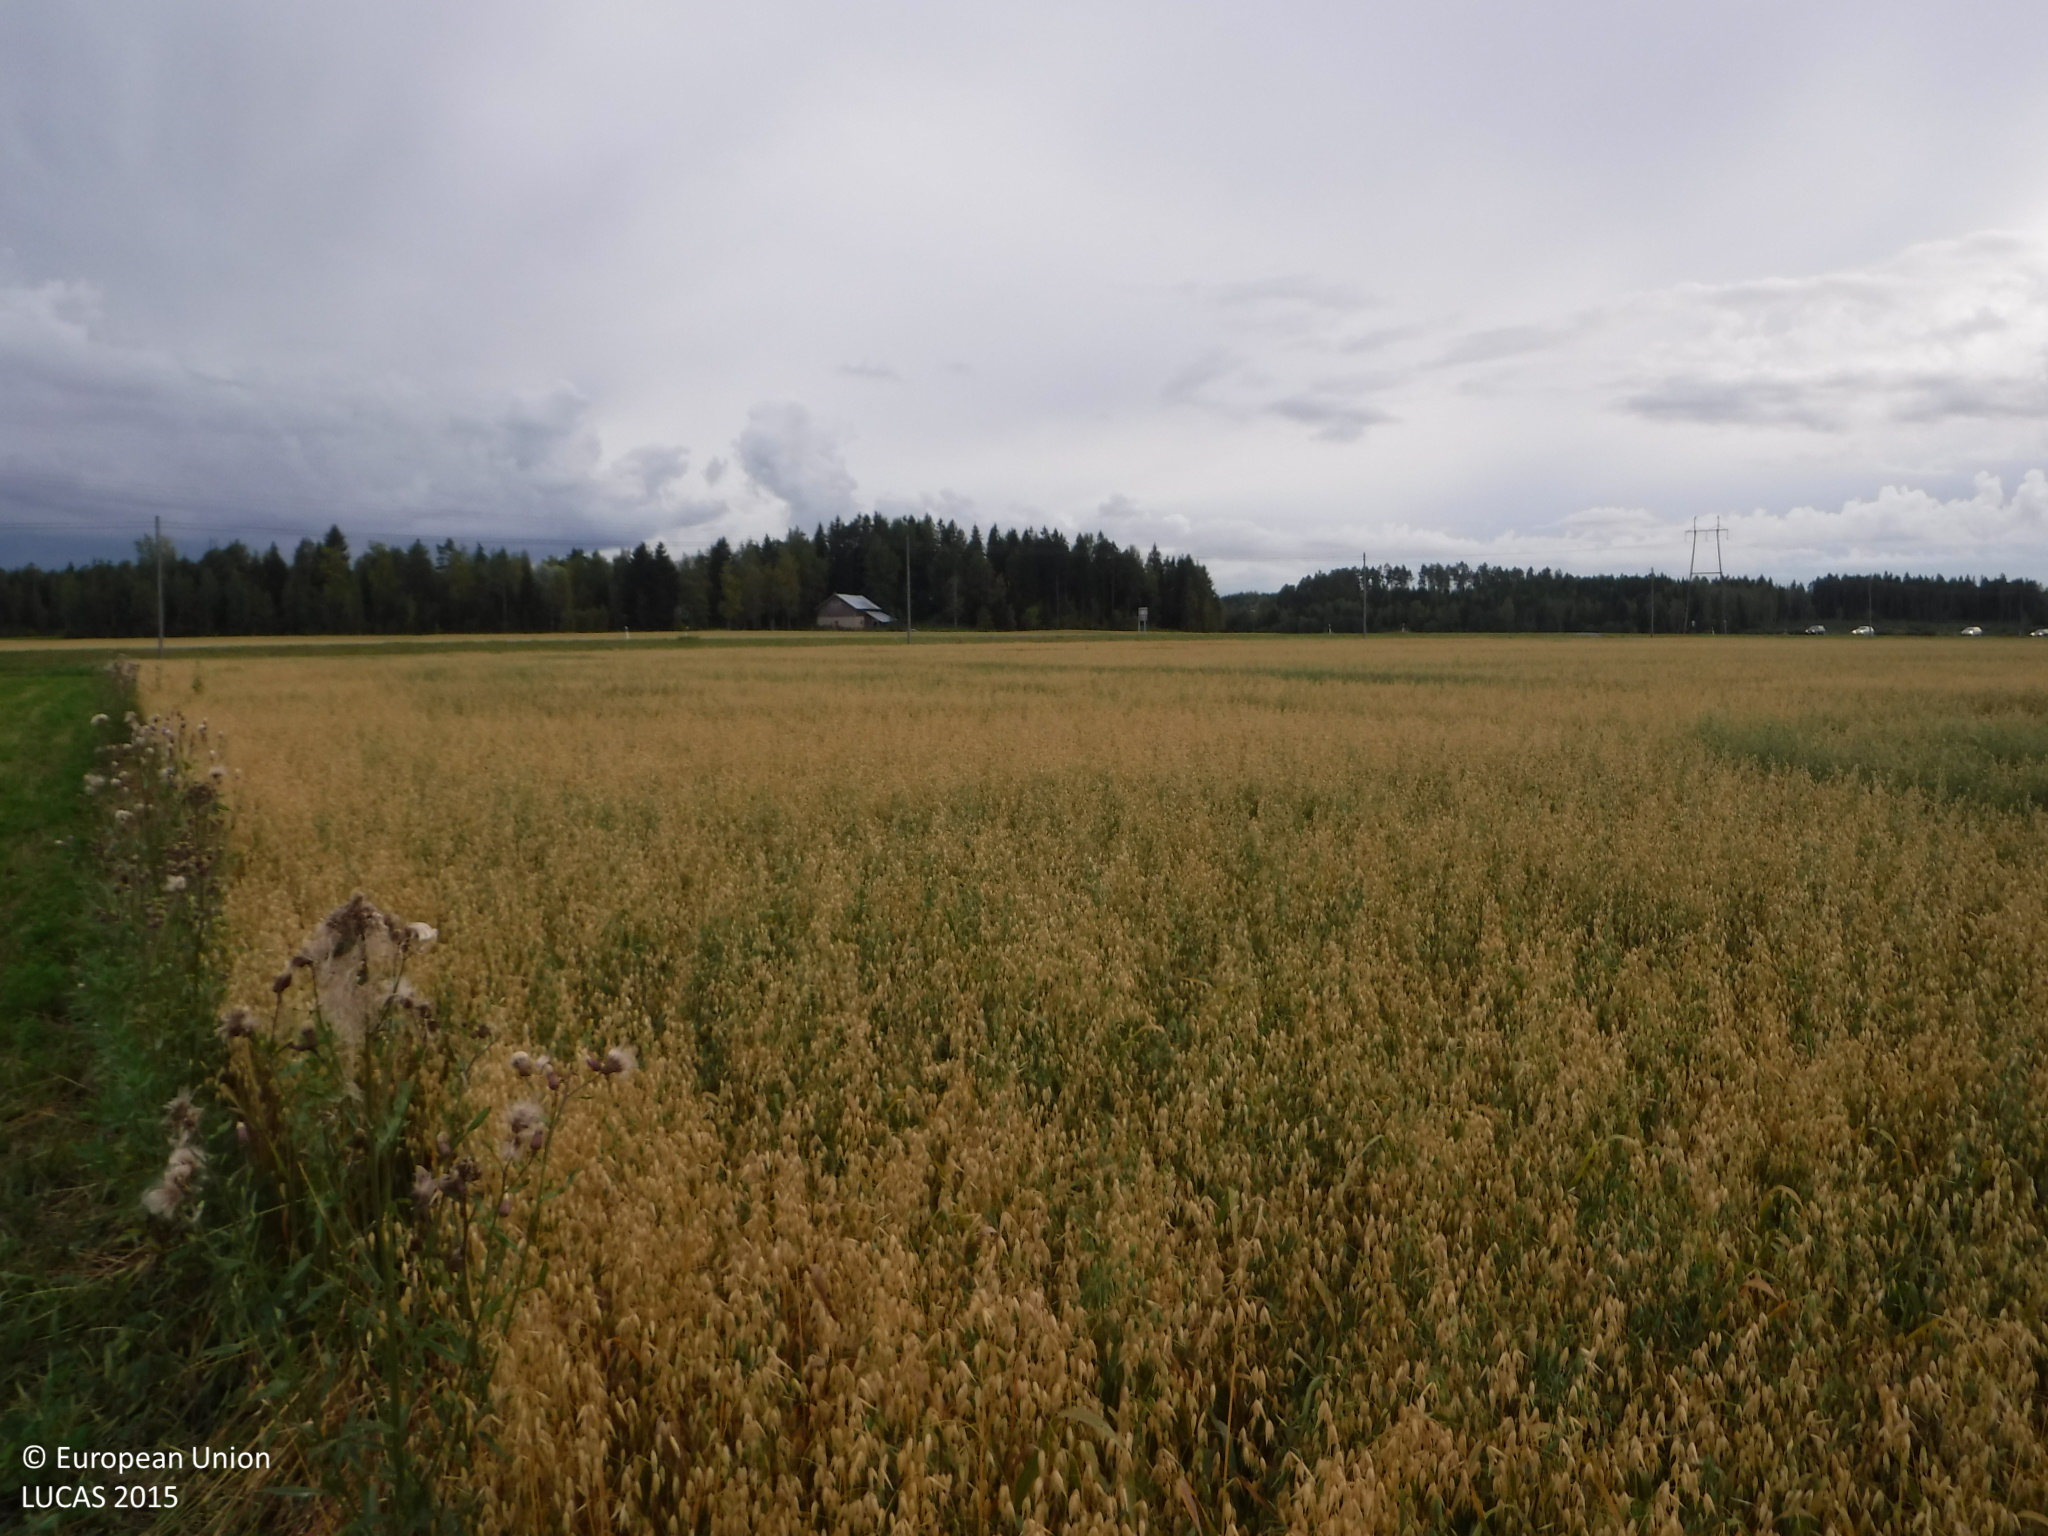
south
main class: Cropland
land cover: Oats
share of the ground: > 75 %
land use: Agriculture (excluding fallow land and kitchen gardens)
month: September
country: FI
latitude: 61.3220
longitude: 22.9041
